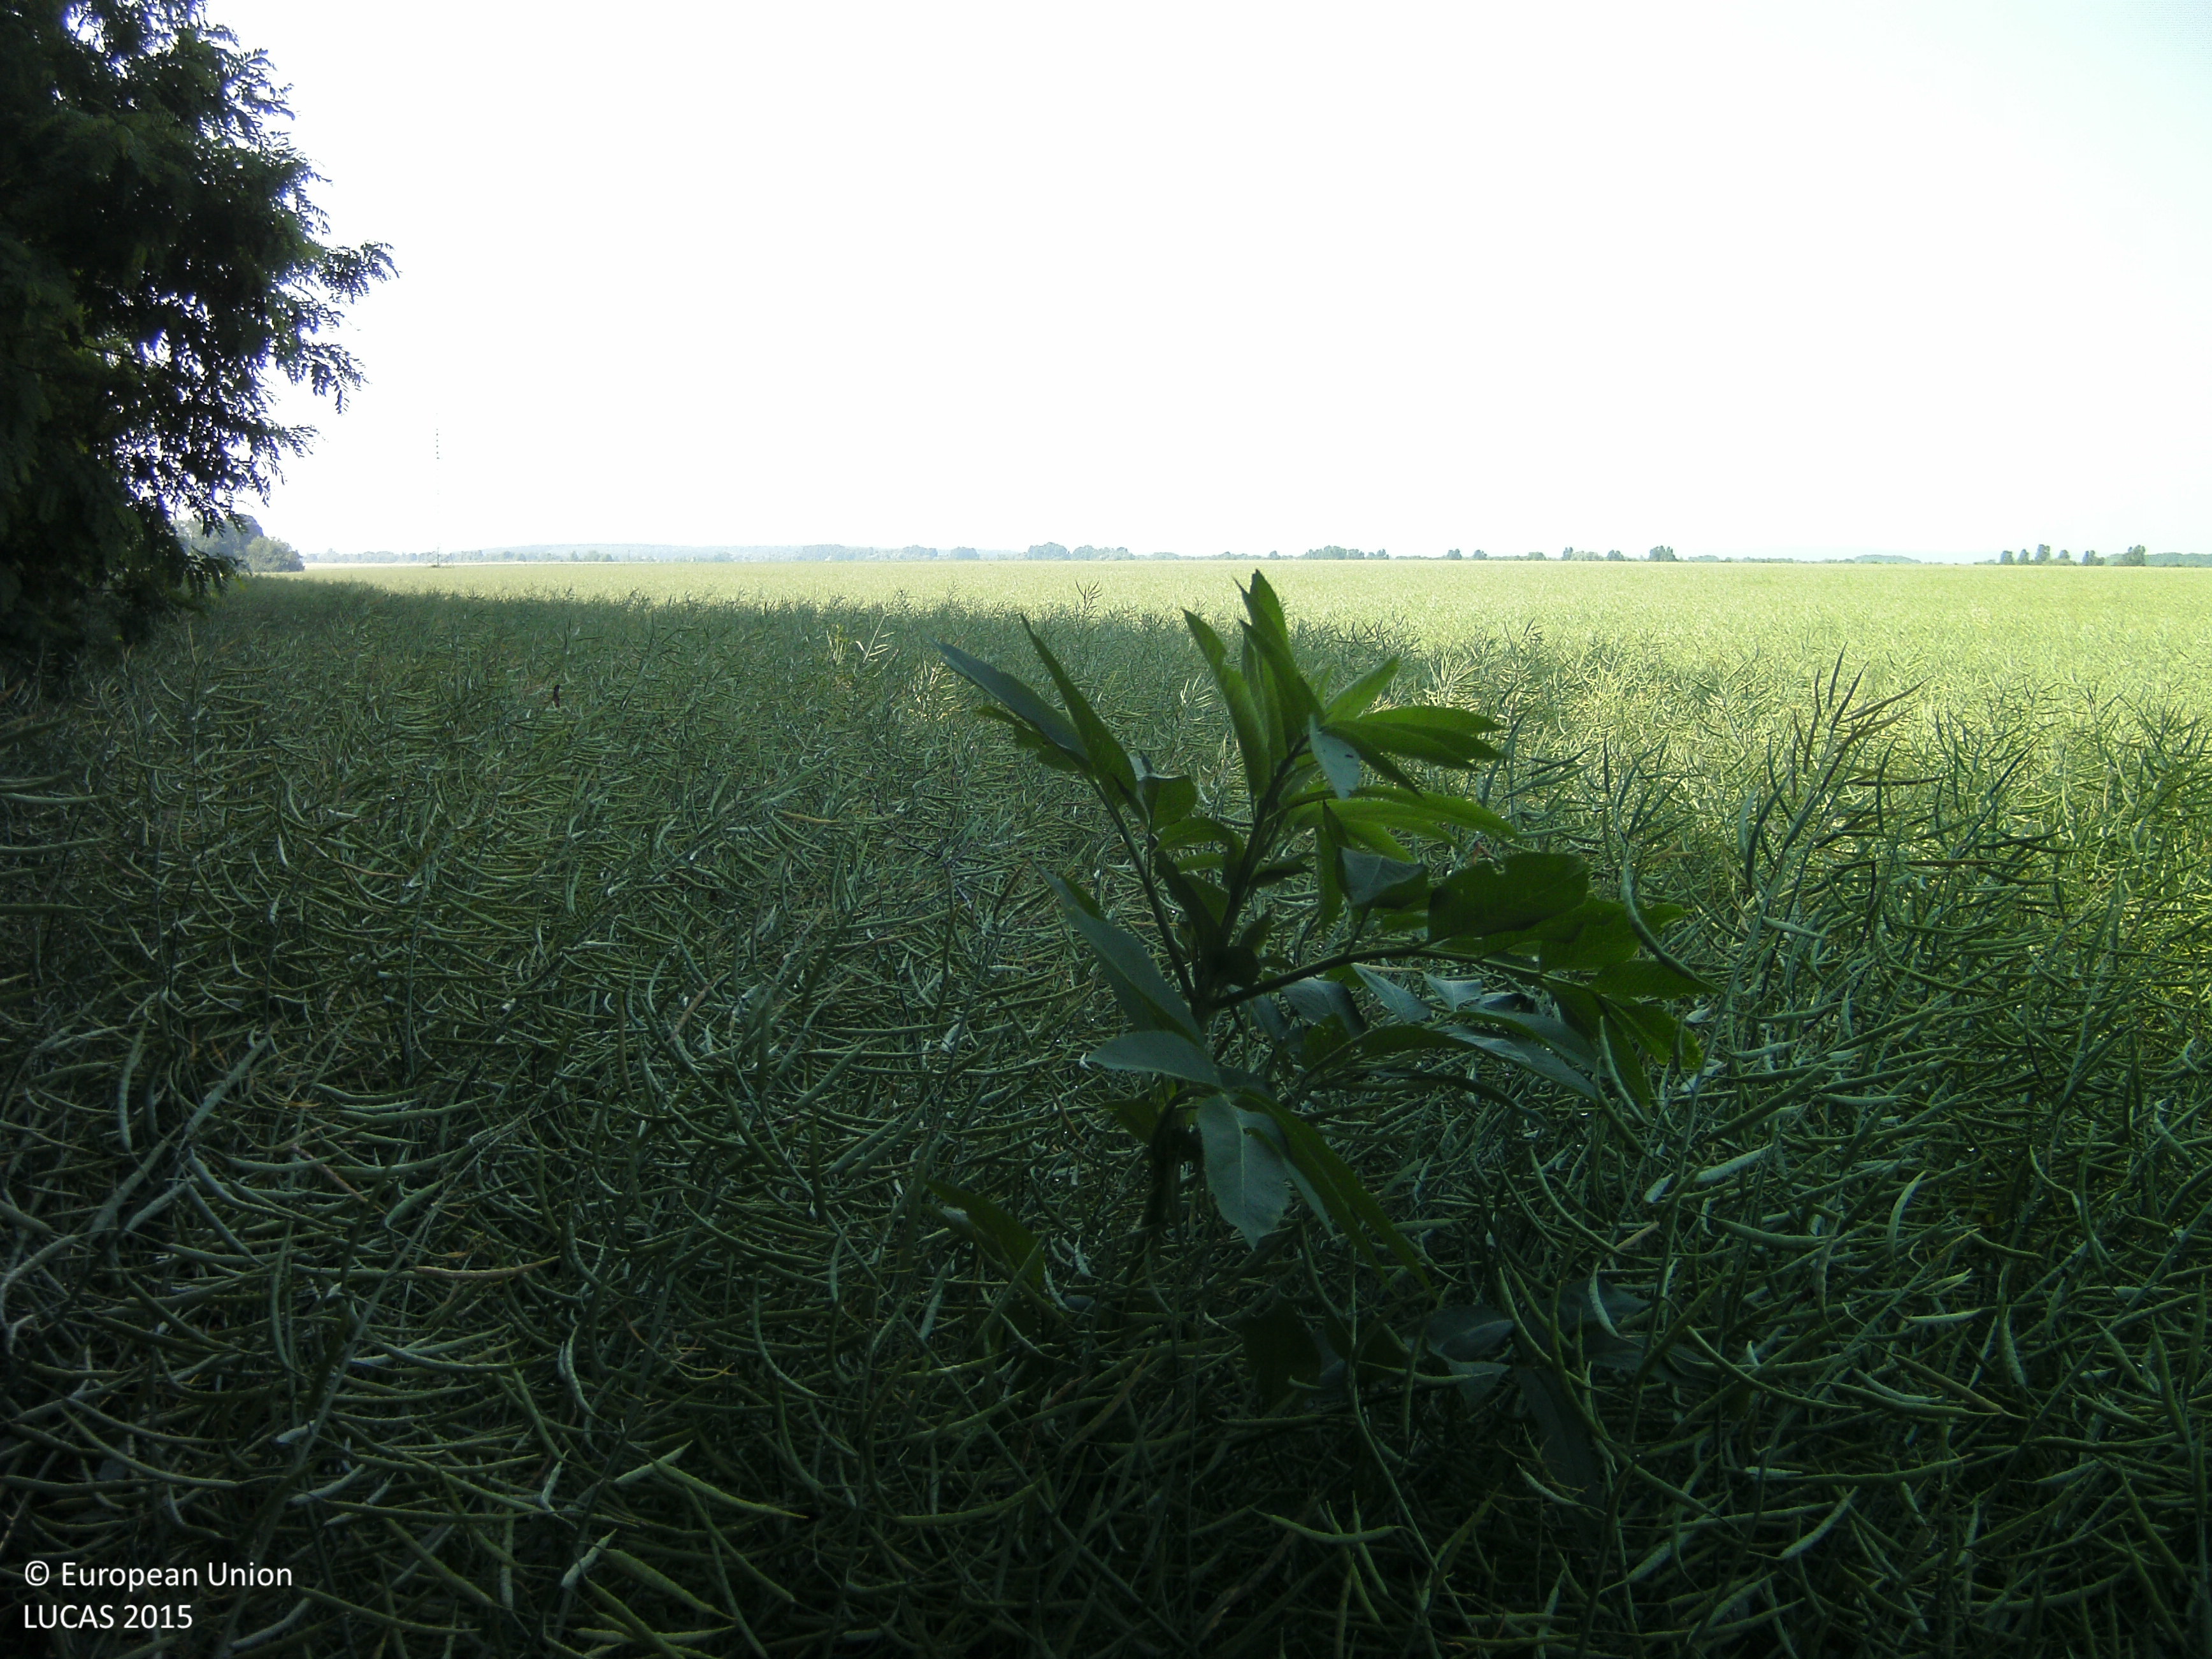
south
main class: Cropland
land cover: Rape and turnip rape
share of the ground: > 75 %
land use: Agriculture (excluding fallow land and kitchen gardens)
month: June
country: HU
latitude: 46.4464
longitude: 18.0392
